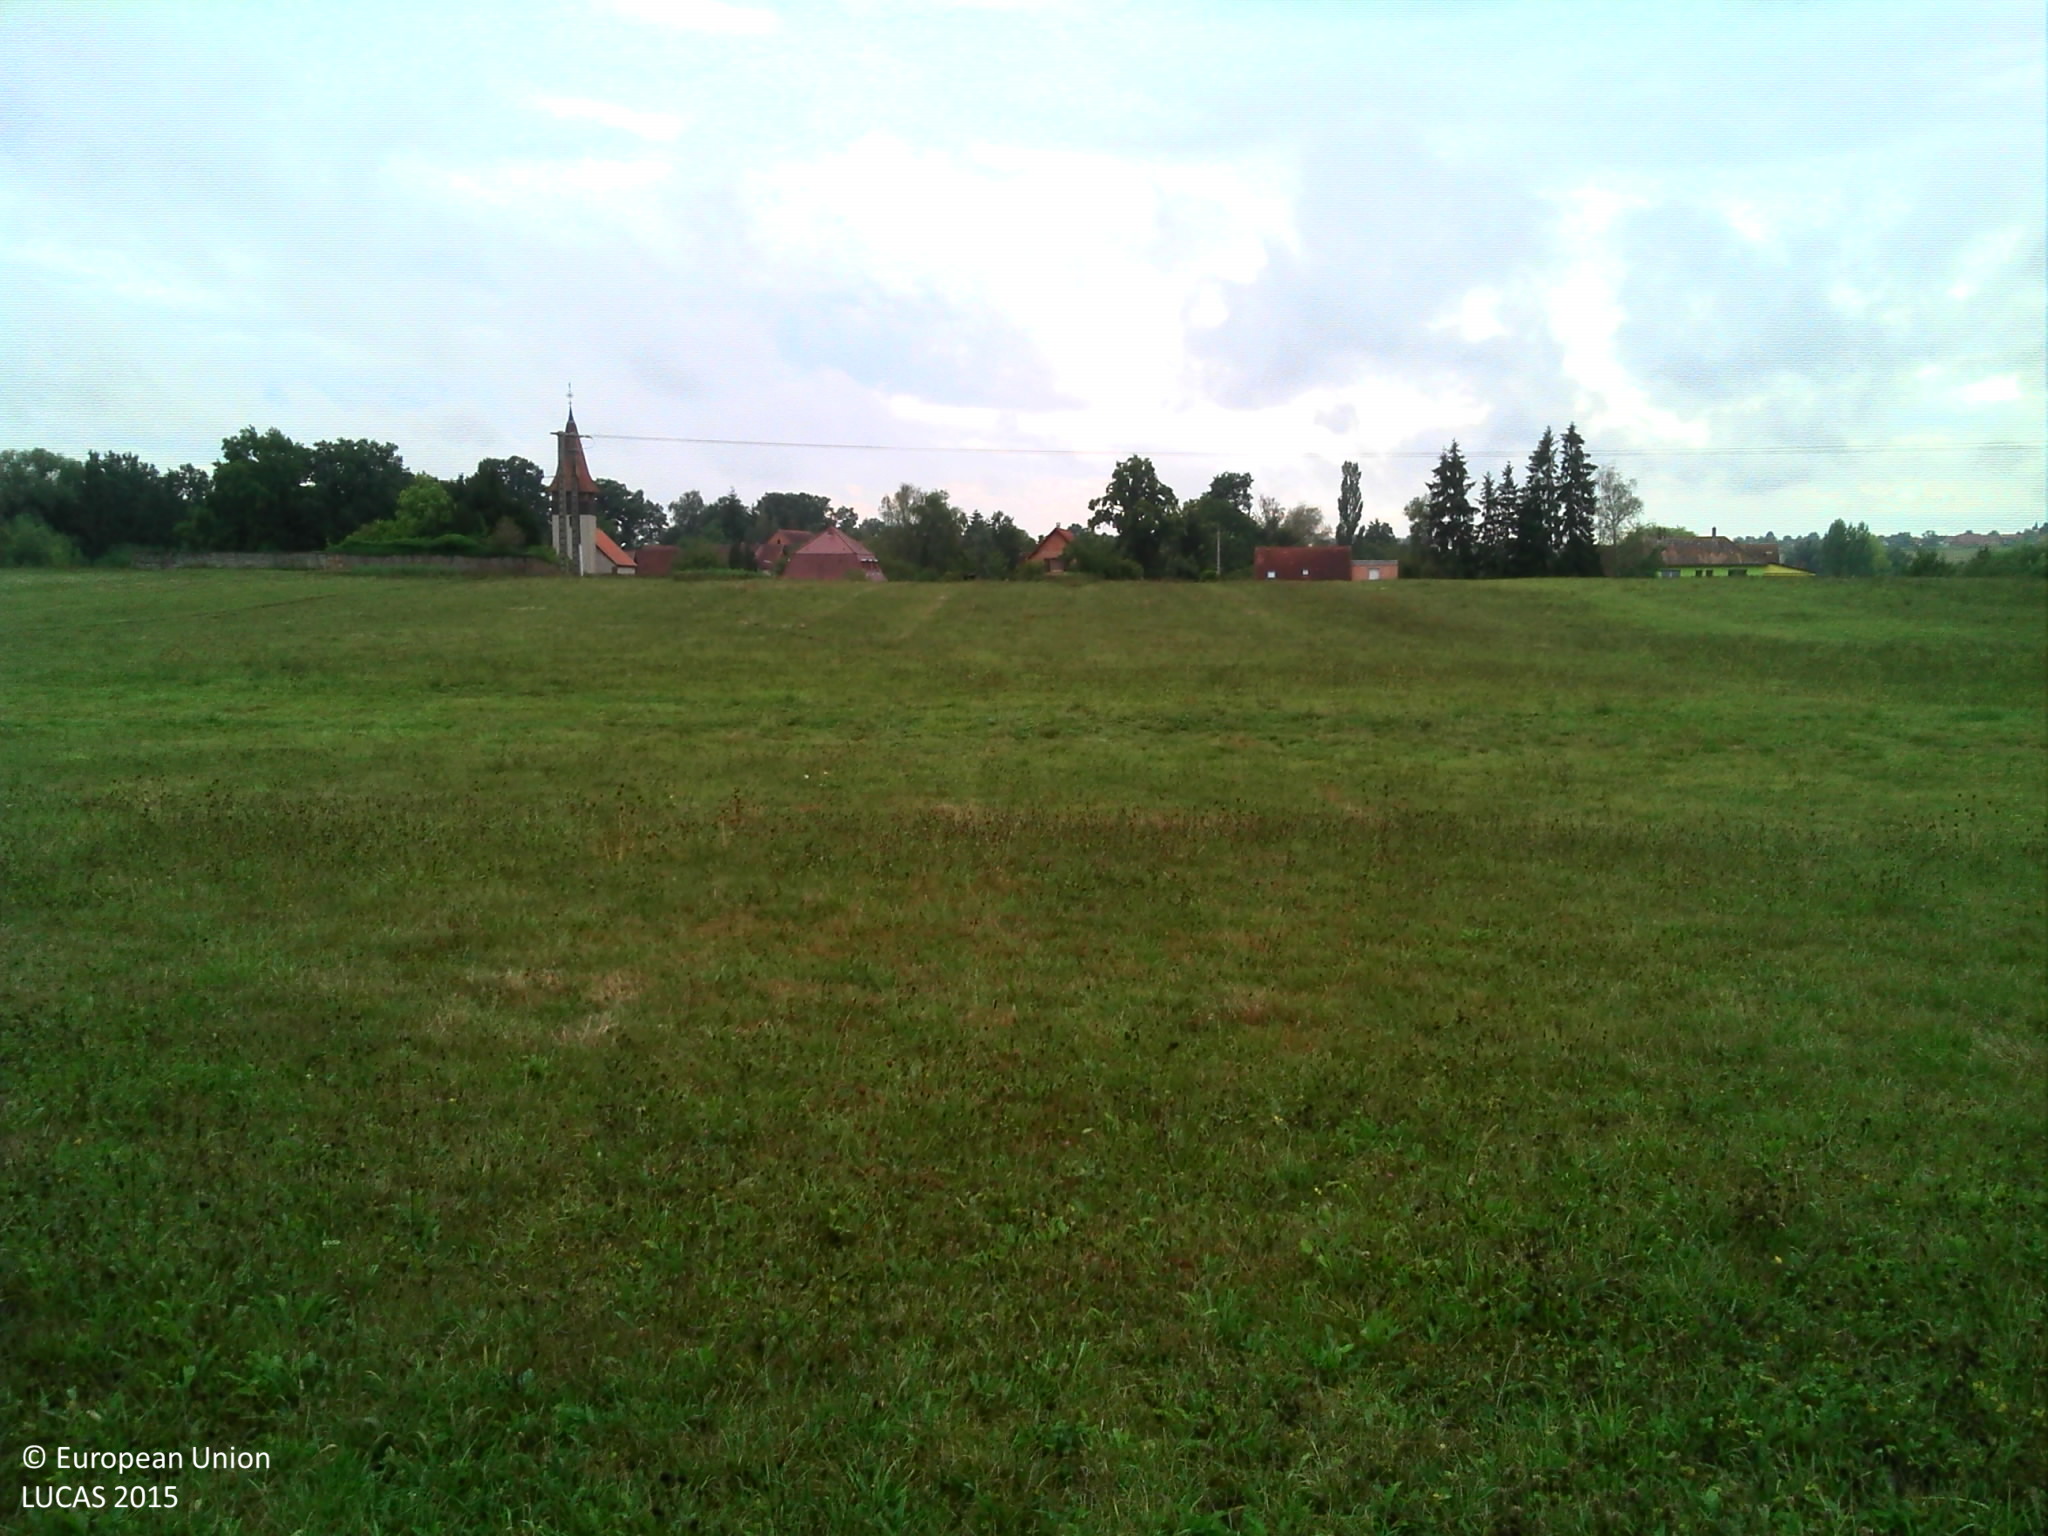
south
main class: Grassland
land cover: Grassland without tree/shrub cover
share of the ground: > 75 %
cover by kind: herbaceous plants 100 %
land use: Agriculture (excluding fallow land and kitchen gardens)
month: August
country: FR
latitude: 48.8081
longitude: 7.5361
